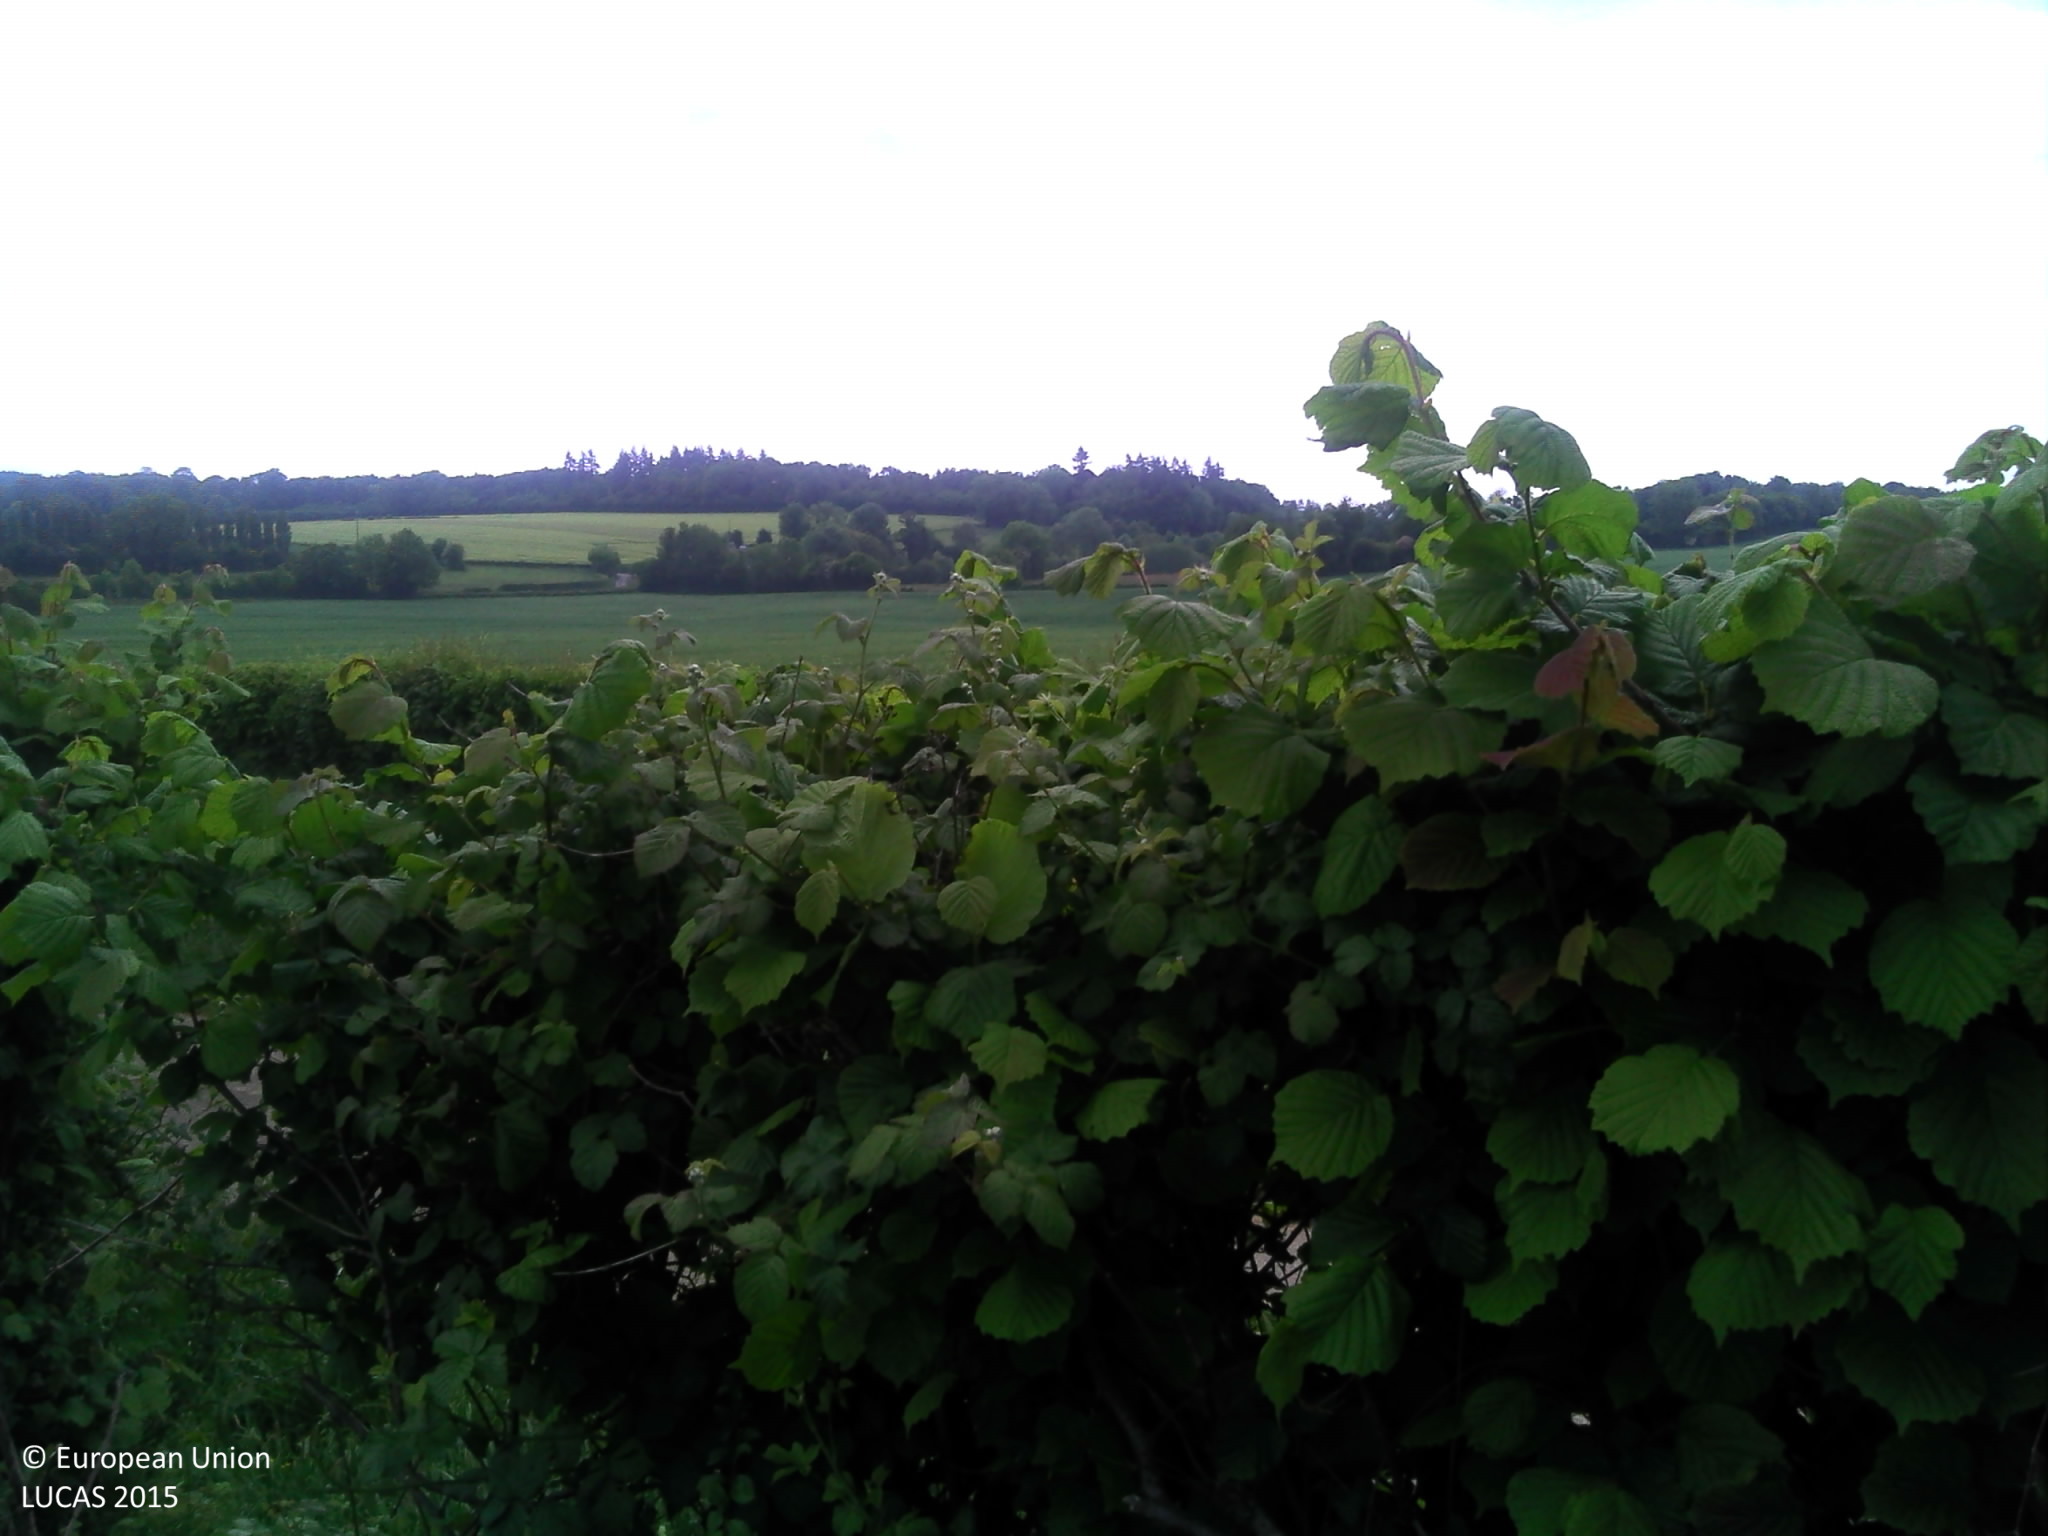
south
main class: Cropland
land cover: Rape and turnip rape
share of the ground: > 75 %
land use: Agriculture (excluding fallow land and kitchen gardens)
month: May
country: FR
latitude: 48.7677
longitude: -0.1681
